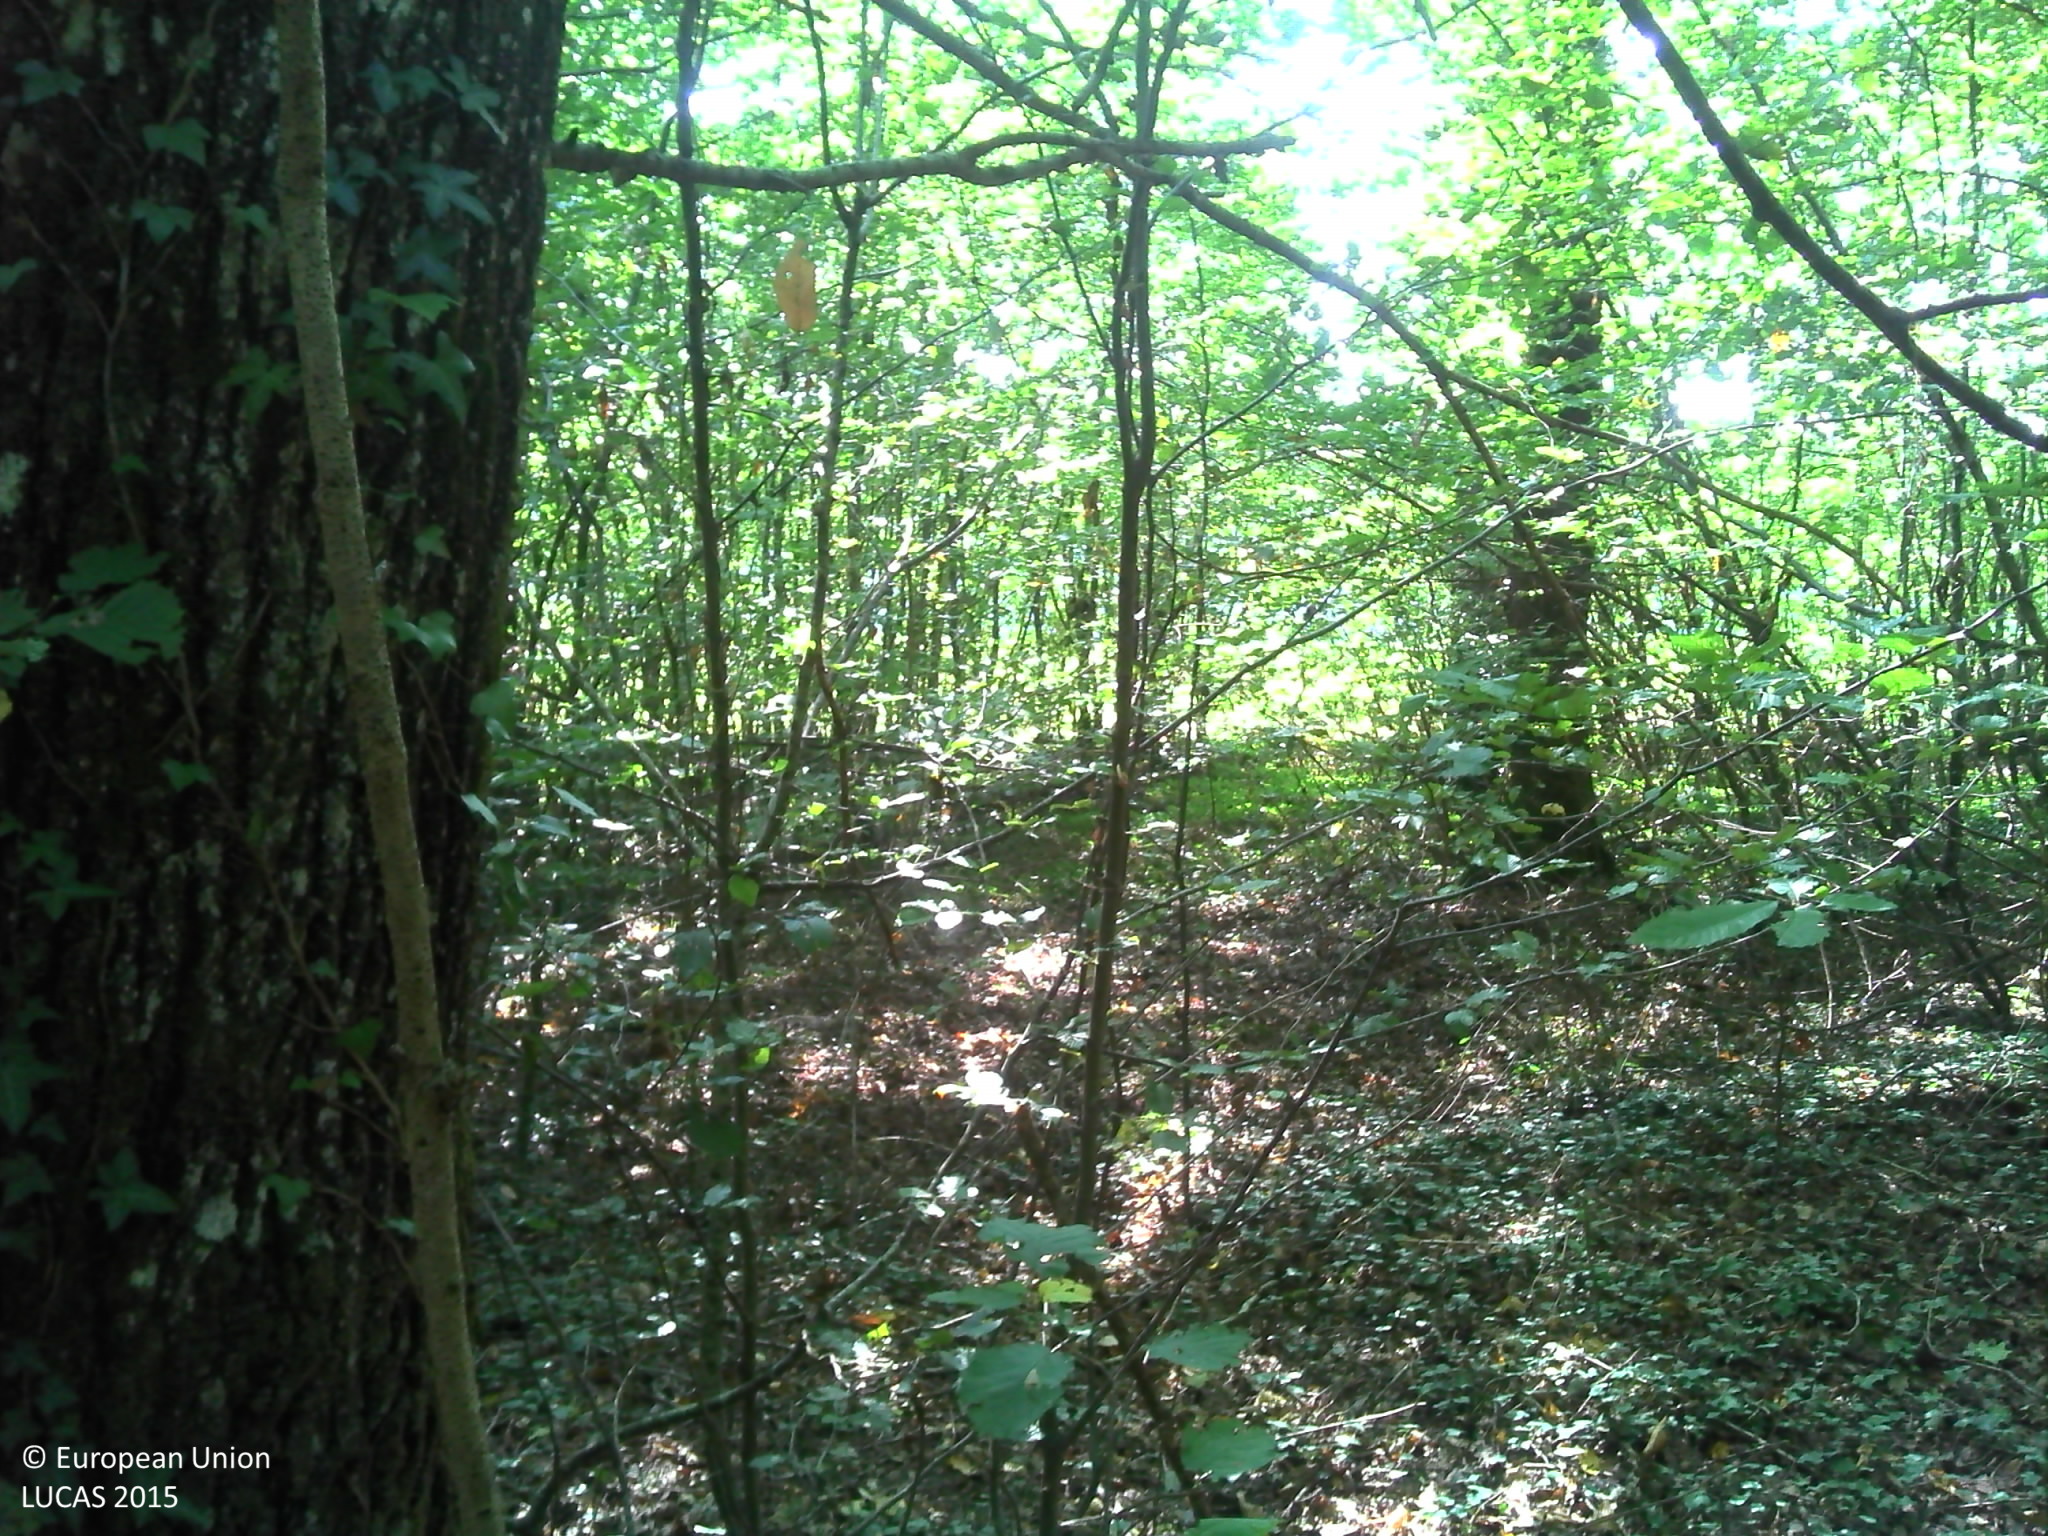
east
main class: Woodland
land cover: Broadleaved woodland
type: mesophytic deciduous forest
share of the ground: > 75 %
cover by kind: broadleaved forest trees 95 %, unconsolidated bare surface 5 %
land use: Forestry
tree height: > 5 m
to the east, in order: Broadleaved woodland; Fences; Spontaneously vegetated surfaces; Fences; Grass margins; Other bare soil; Grass margins; Broadleaved woodland
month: September
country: FR
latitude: 47.0400
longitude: 1.4459
